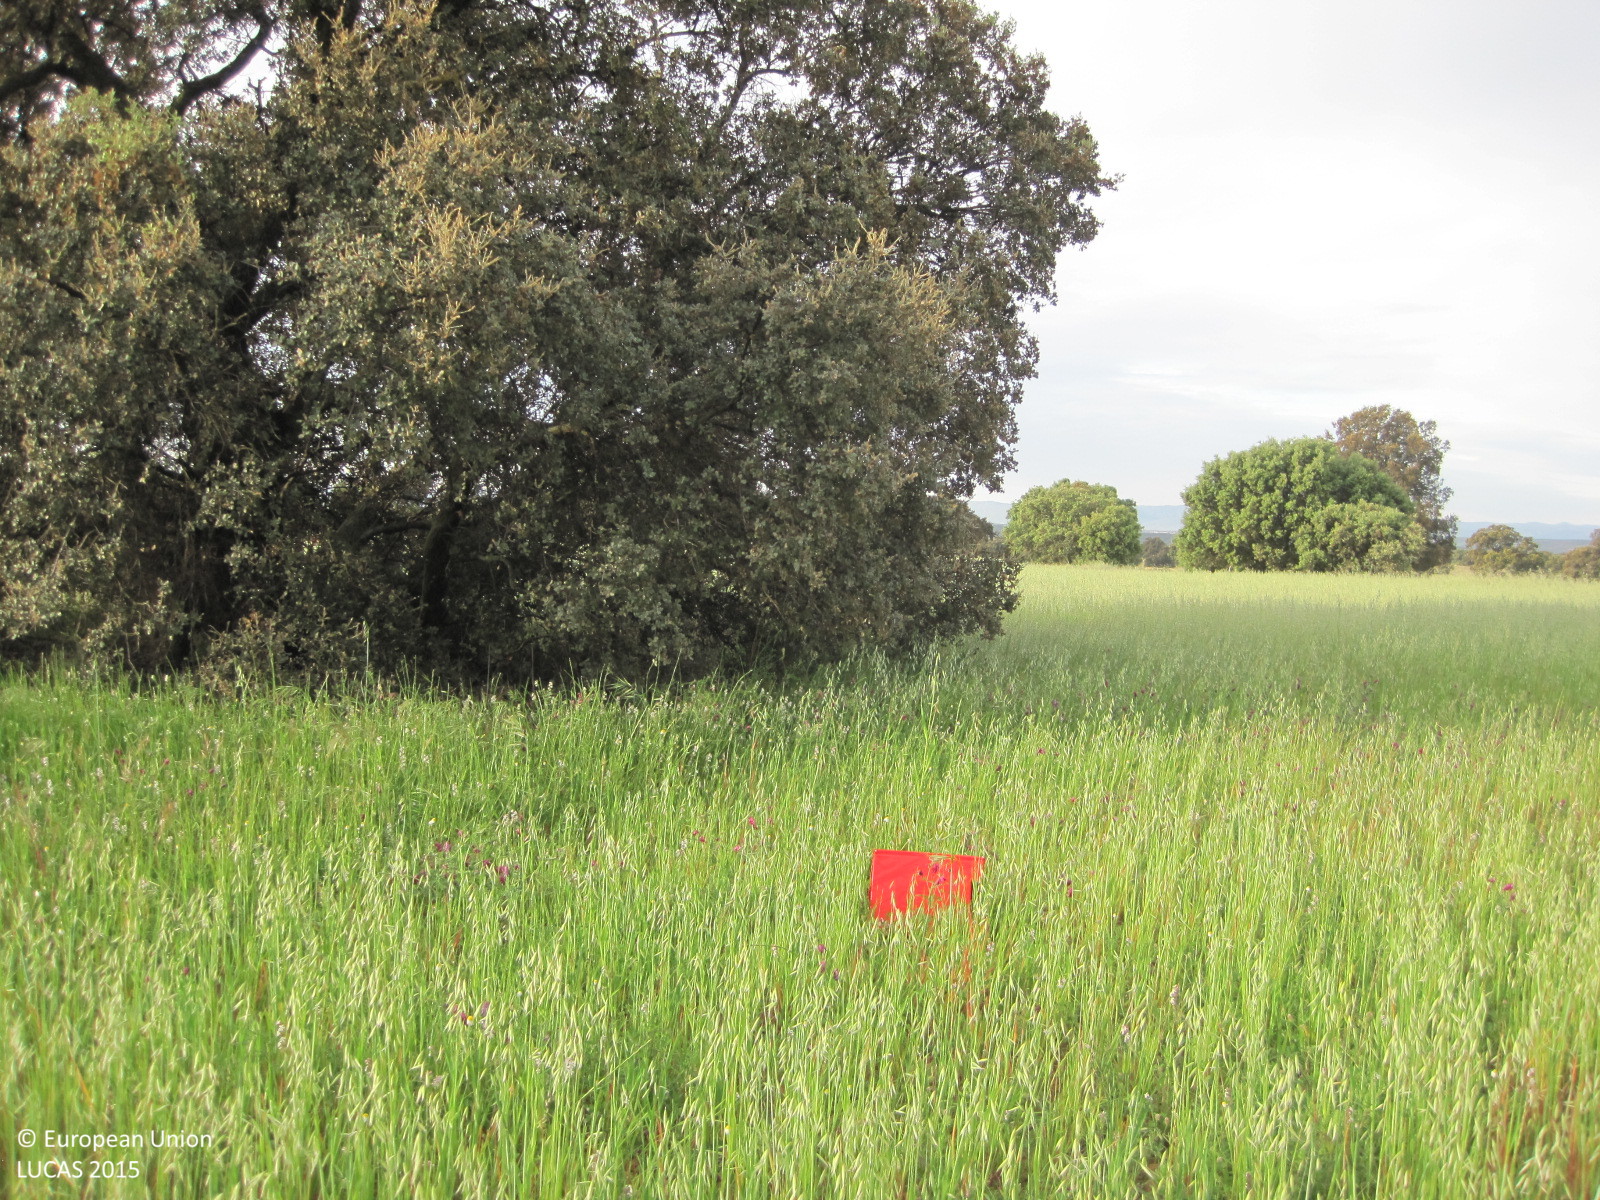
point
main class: Cropland
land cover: Oats
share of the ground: > 75 %
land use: Agriculture (excluding fallow land and kitchen gardens)
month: May
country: ES
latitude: 39.8347
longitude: -4.6851
